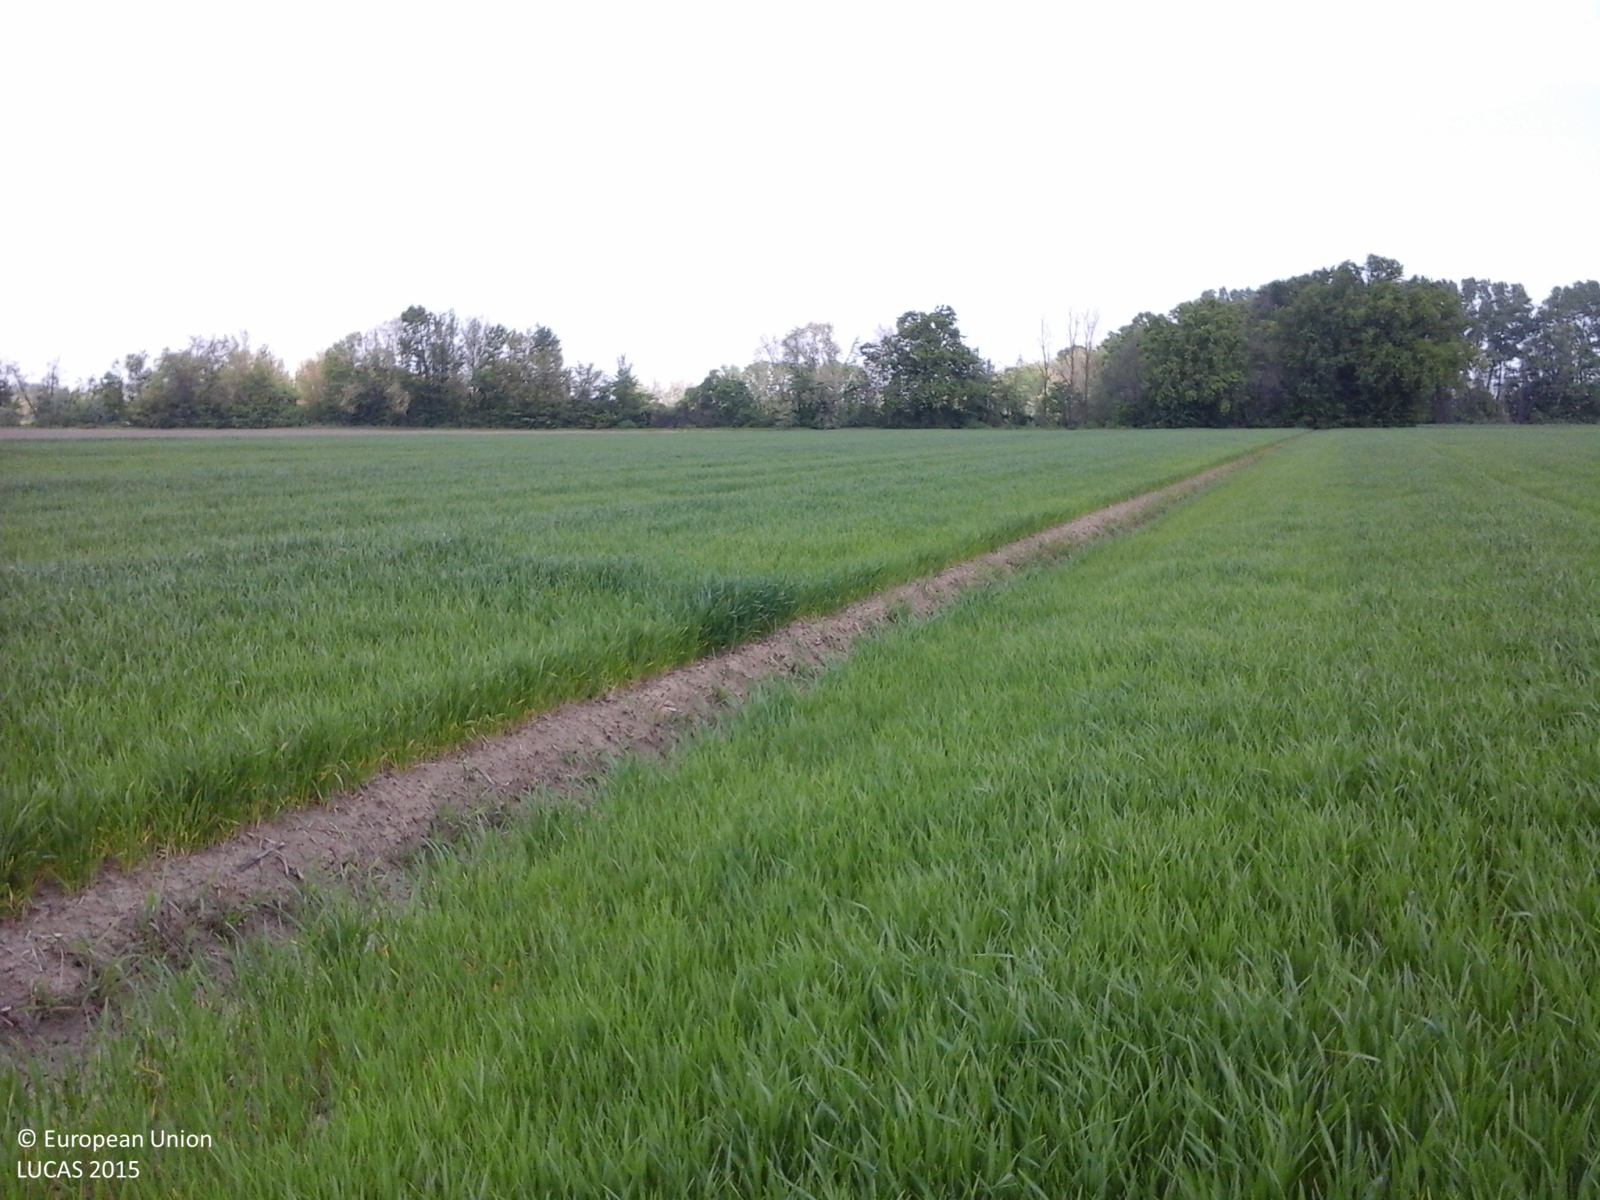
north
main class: Cropland
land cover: Common wheat
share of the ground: > 75 %
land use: Agriculture (excluding fallow land and kitchen gardens)
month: April
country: IT
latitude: 44.9057
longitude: 10.8974
